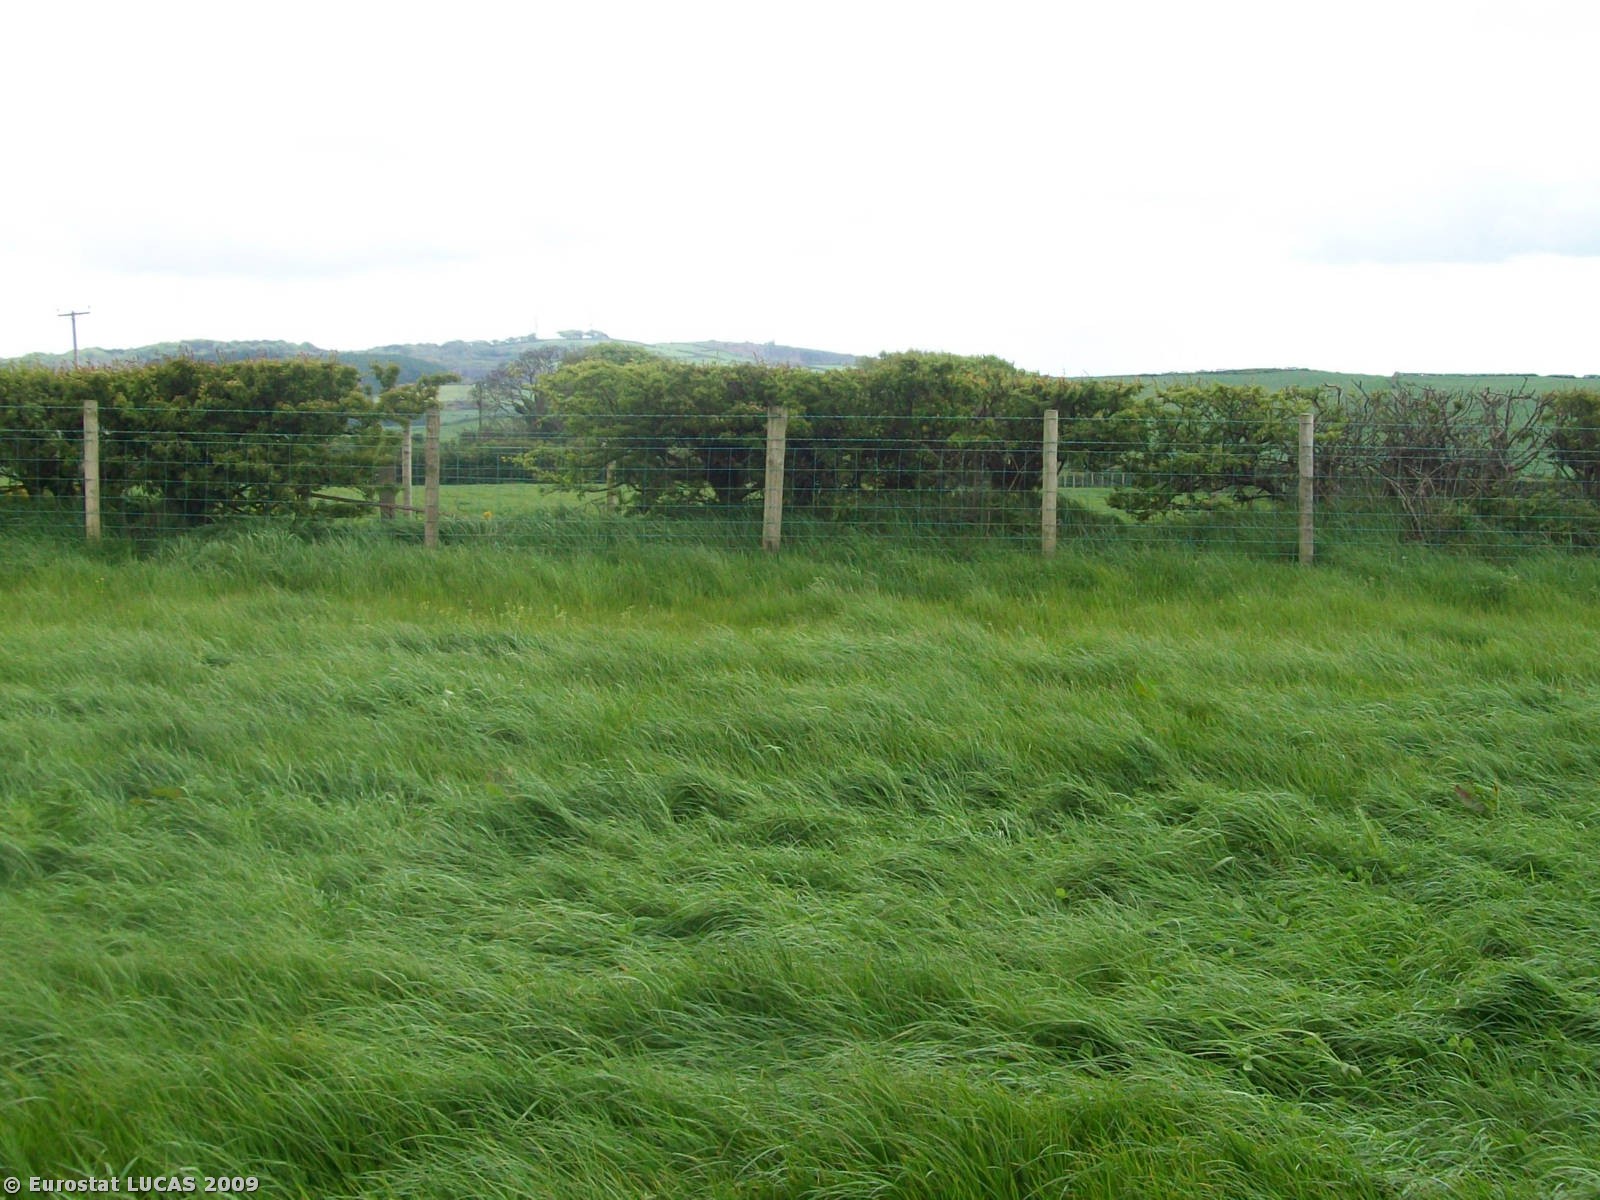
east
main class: Grassland
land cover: Grassland without tree/shrub cover
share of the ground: > 75 %
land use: Agriculture (excluding fallow land and kitchen gardens)
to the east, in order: Grassland without tree/shrub cover; Fences; Managed hedges; Grass margins; Tracks; Grass margins; Fences; Grassland without tree/shrub cover; Fences; Abandoned hedges; Grass margins; Artificial constructions in urban areas; Tracks; Grass margins; Fences; Grassland without tree/shrub cover; Abandoned hedges; Grassland without tree/shrub cover
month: May
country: GB
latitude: 54.6134
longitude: -5.7894
